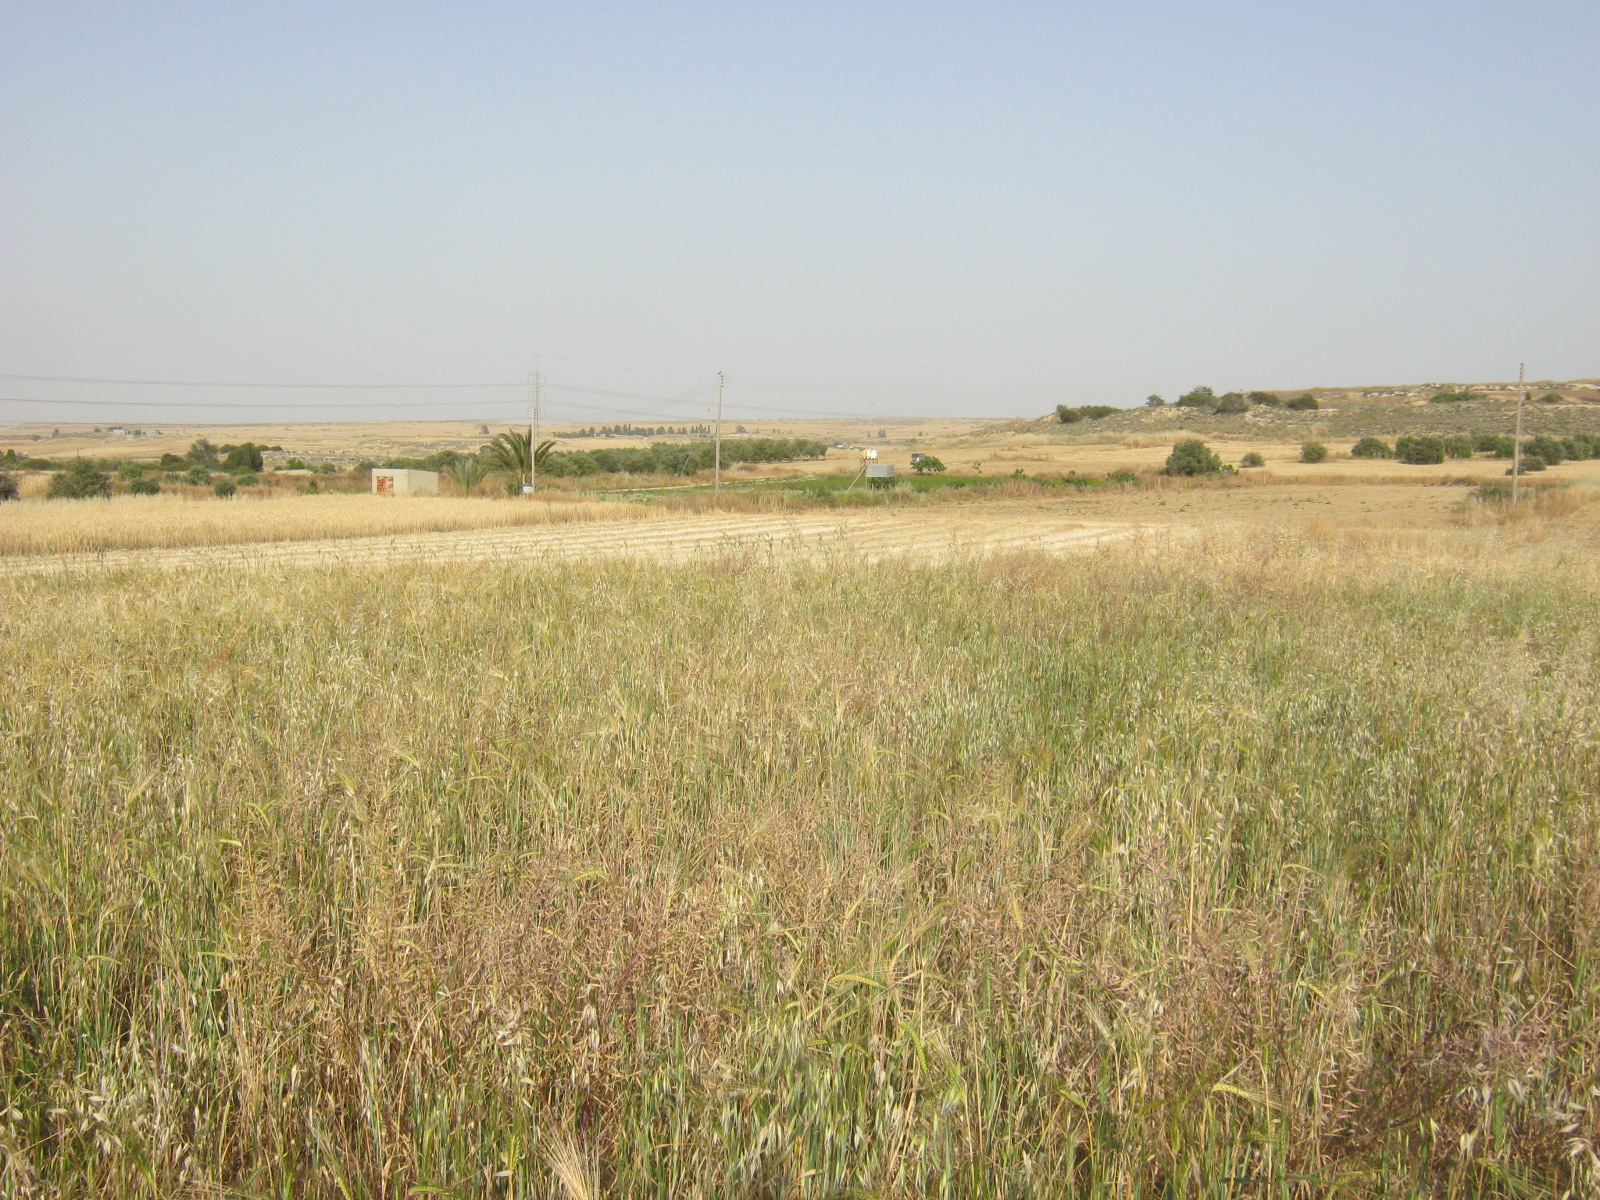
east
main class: Cropland
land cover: Mixed cereals for fodder
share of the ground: > 75 %
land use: Agriculture (excluding fallow land and kitchen gardens)
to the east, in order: Mixed cereals for fodder; Other bare soil; Spontaneously vegetated surfaces; Other bare soil; Spontaneously vegetated surfaces; Tracks; Grass margins; Other bare soil
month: April
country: CY
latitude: 35.1164
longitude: 33.4231
